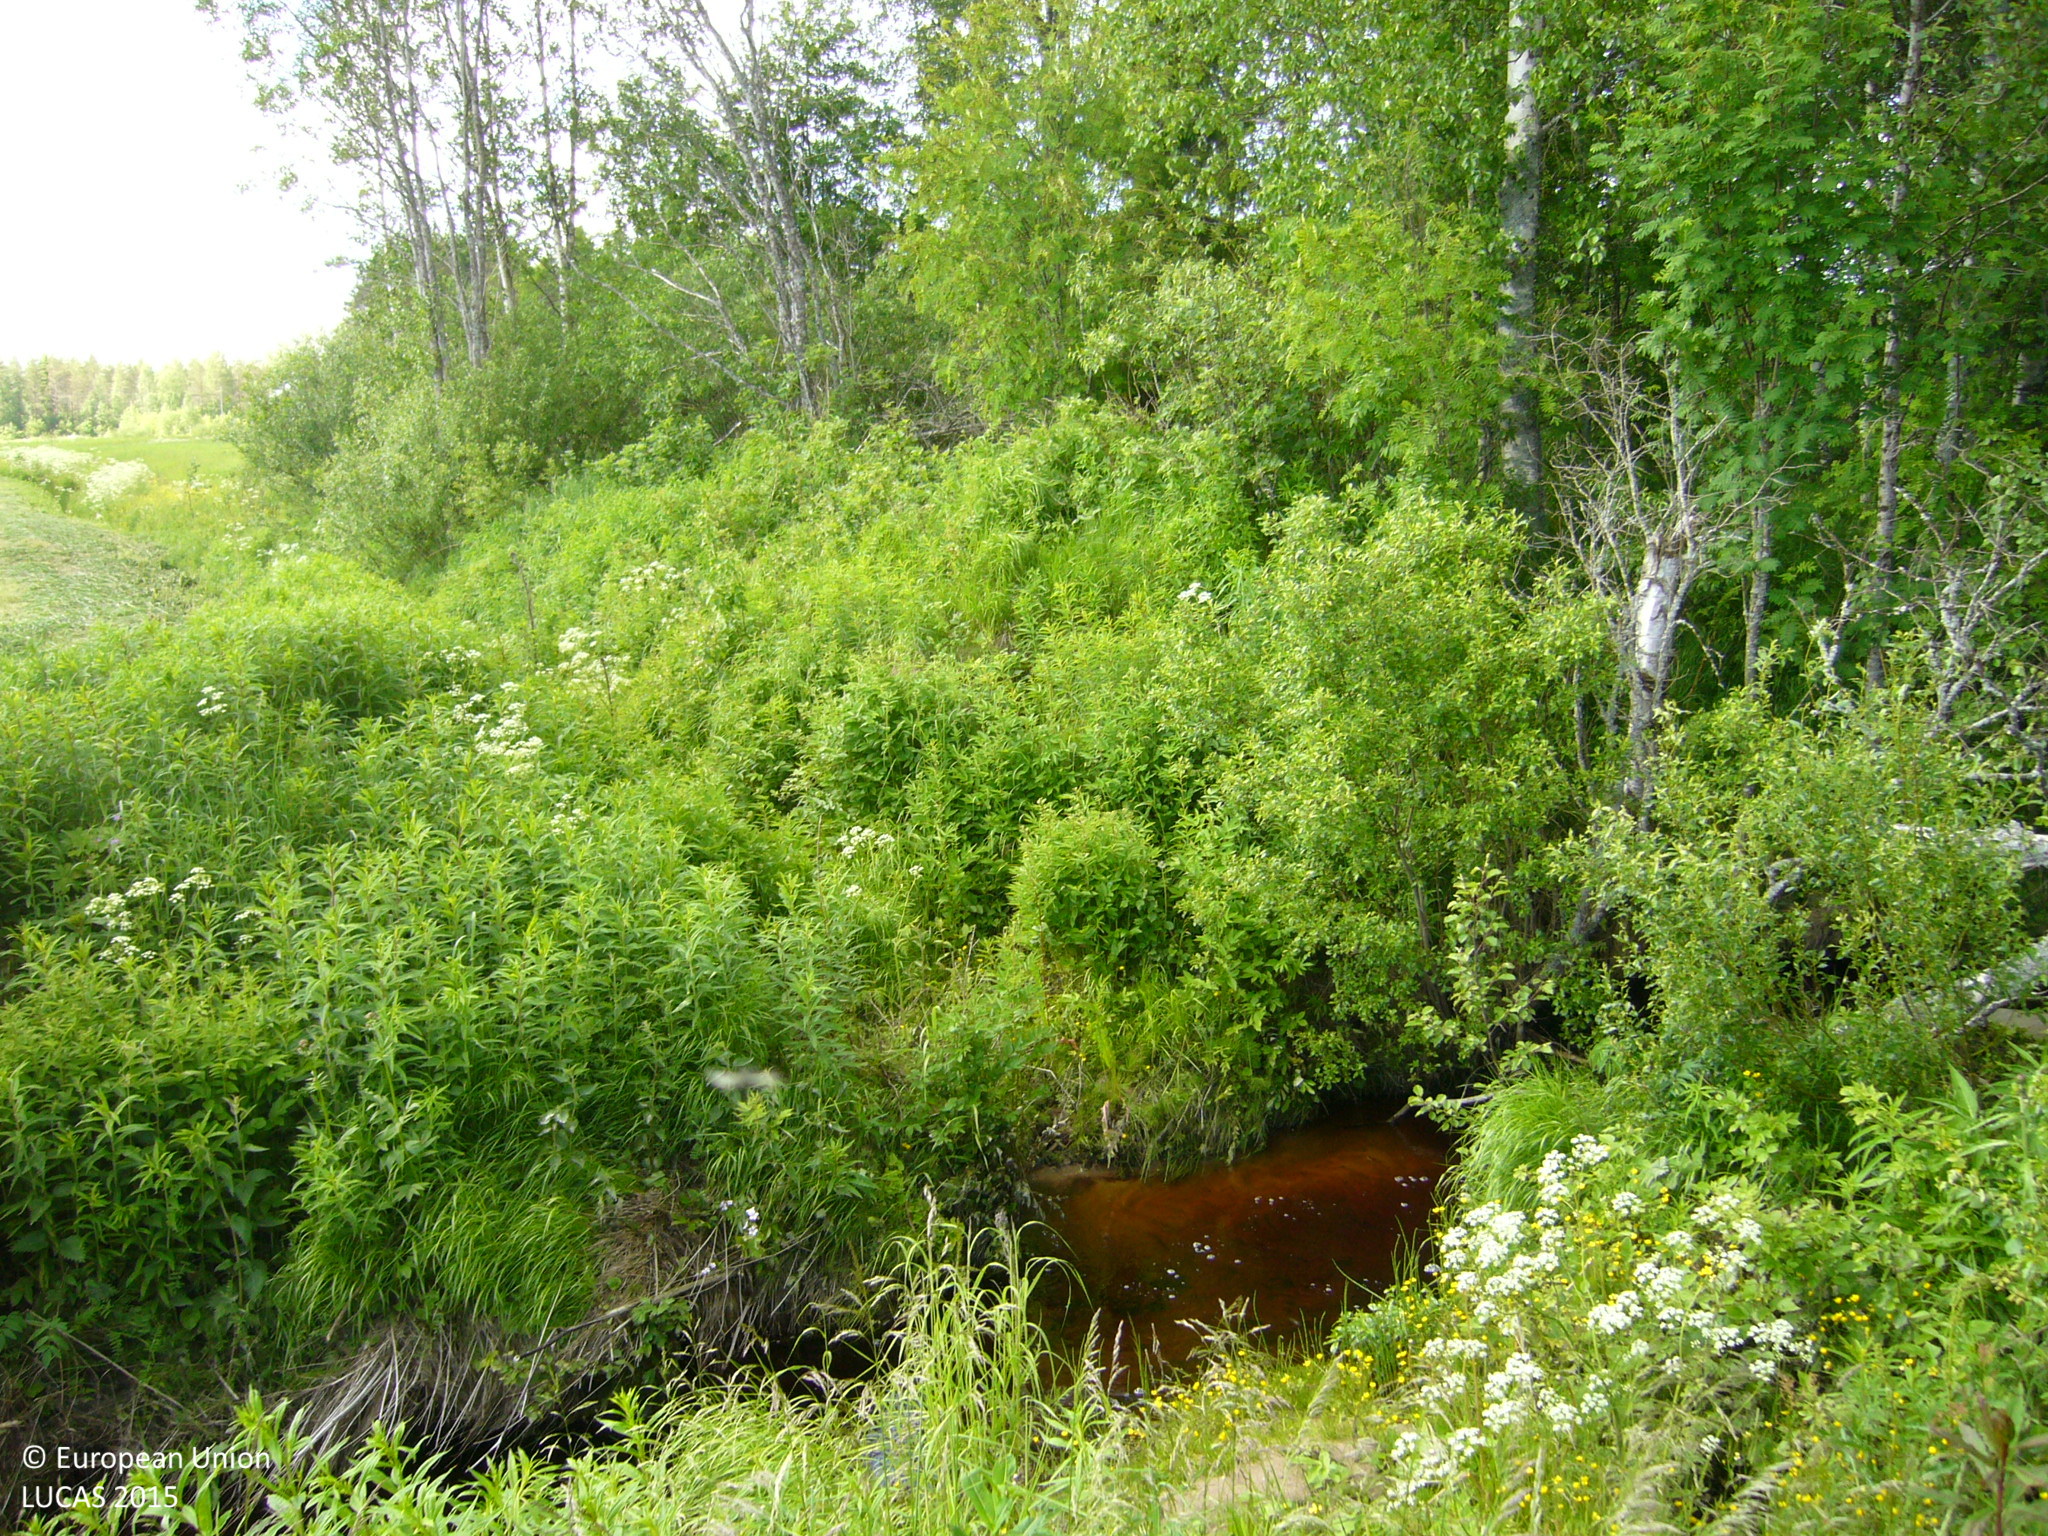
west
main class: Woodland
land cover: Broadleaved woodland
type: boreal forest
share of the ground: > 75 %
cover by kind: broadleaved forest trees 90 %, coniferous forest trees 5 %, shrubs 5 %
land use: Forestry
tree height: > 5 m
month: June
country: FI
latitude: 63.8449
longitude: 26.2818
